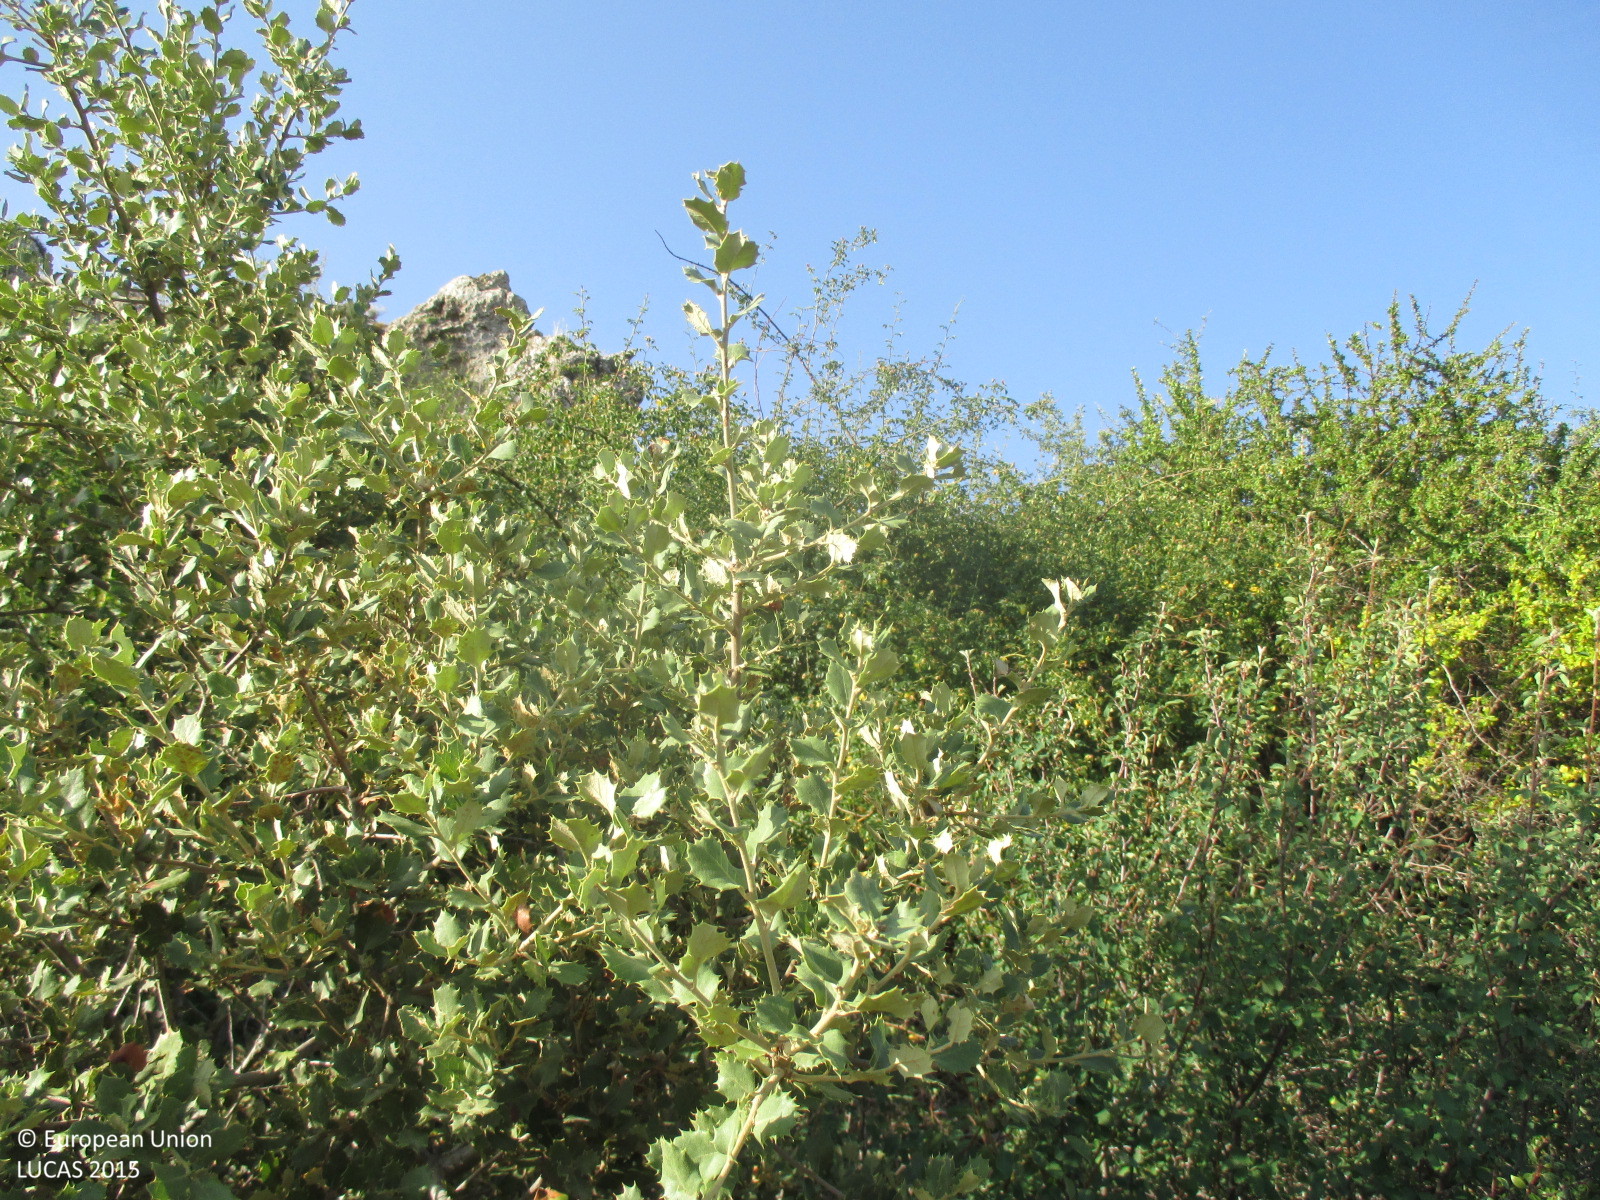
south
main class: Shrubland
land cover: Shrubland without tree cover
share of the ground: > 75 %
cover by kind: shrubs 90 %, herbaceous plants 10 %
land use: Semi-natural and natural areas not in use
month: July
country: ES
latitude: 38.0856
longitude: -2.4087
